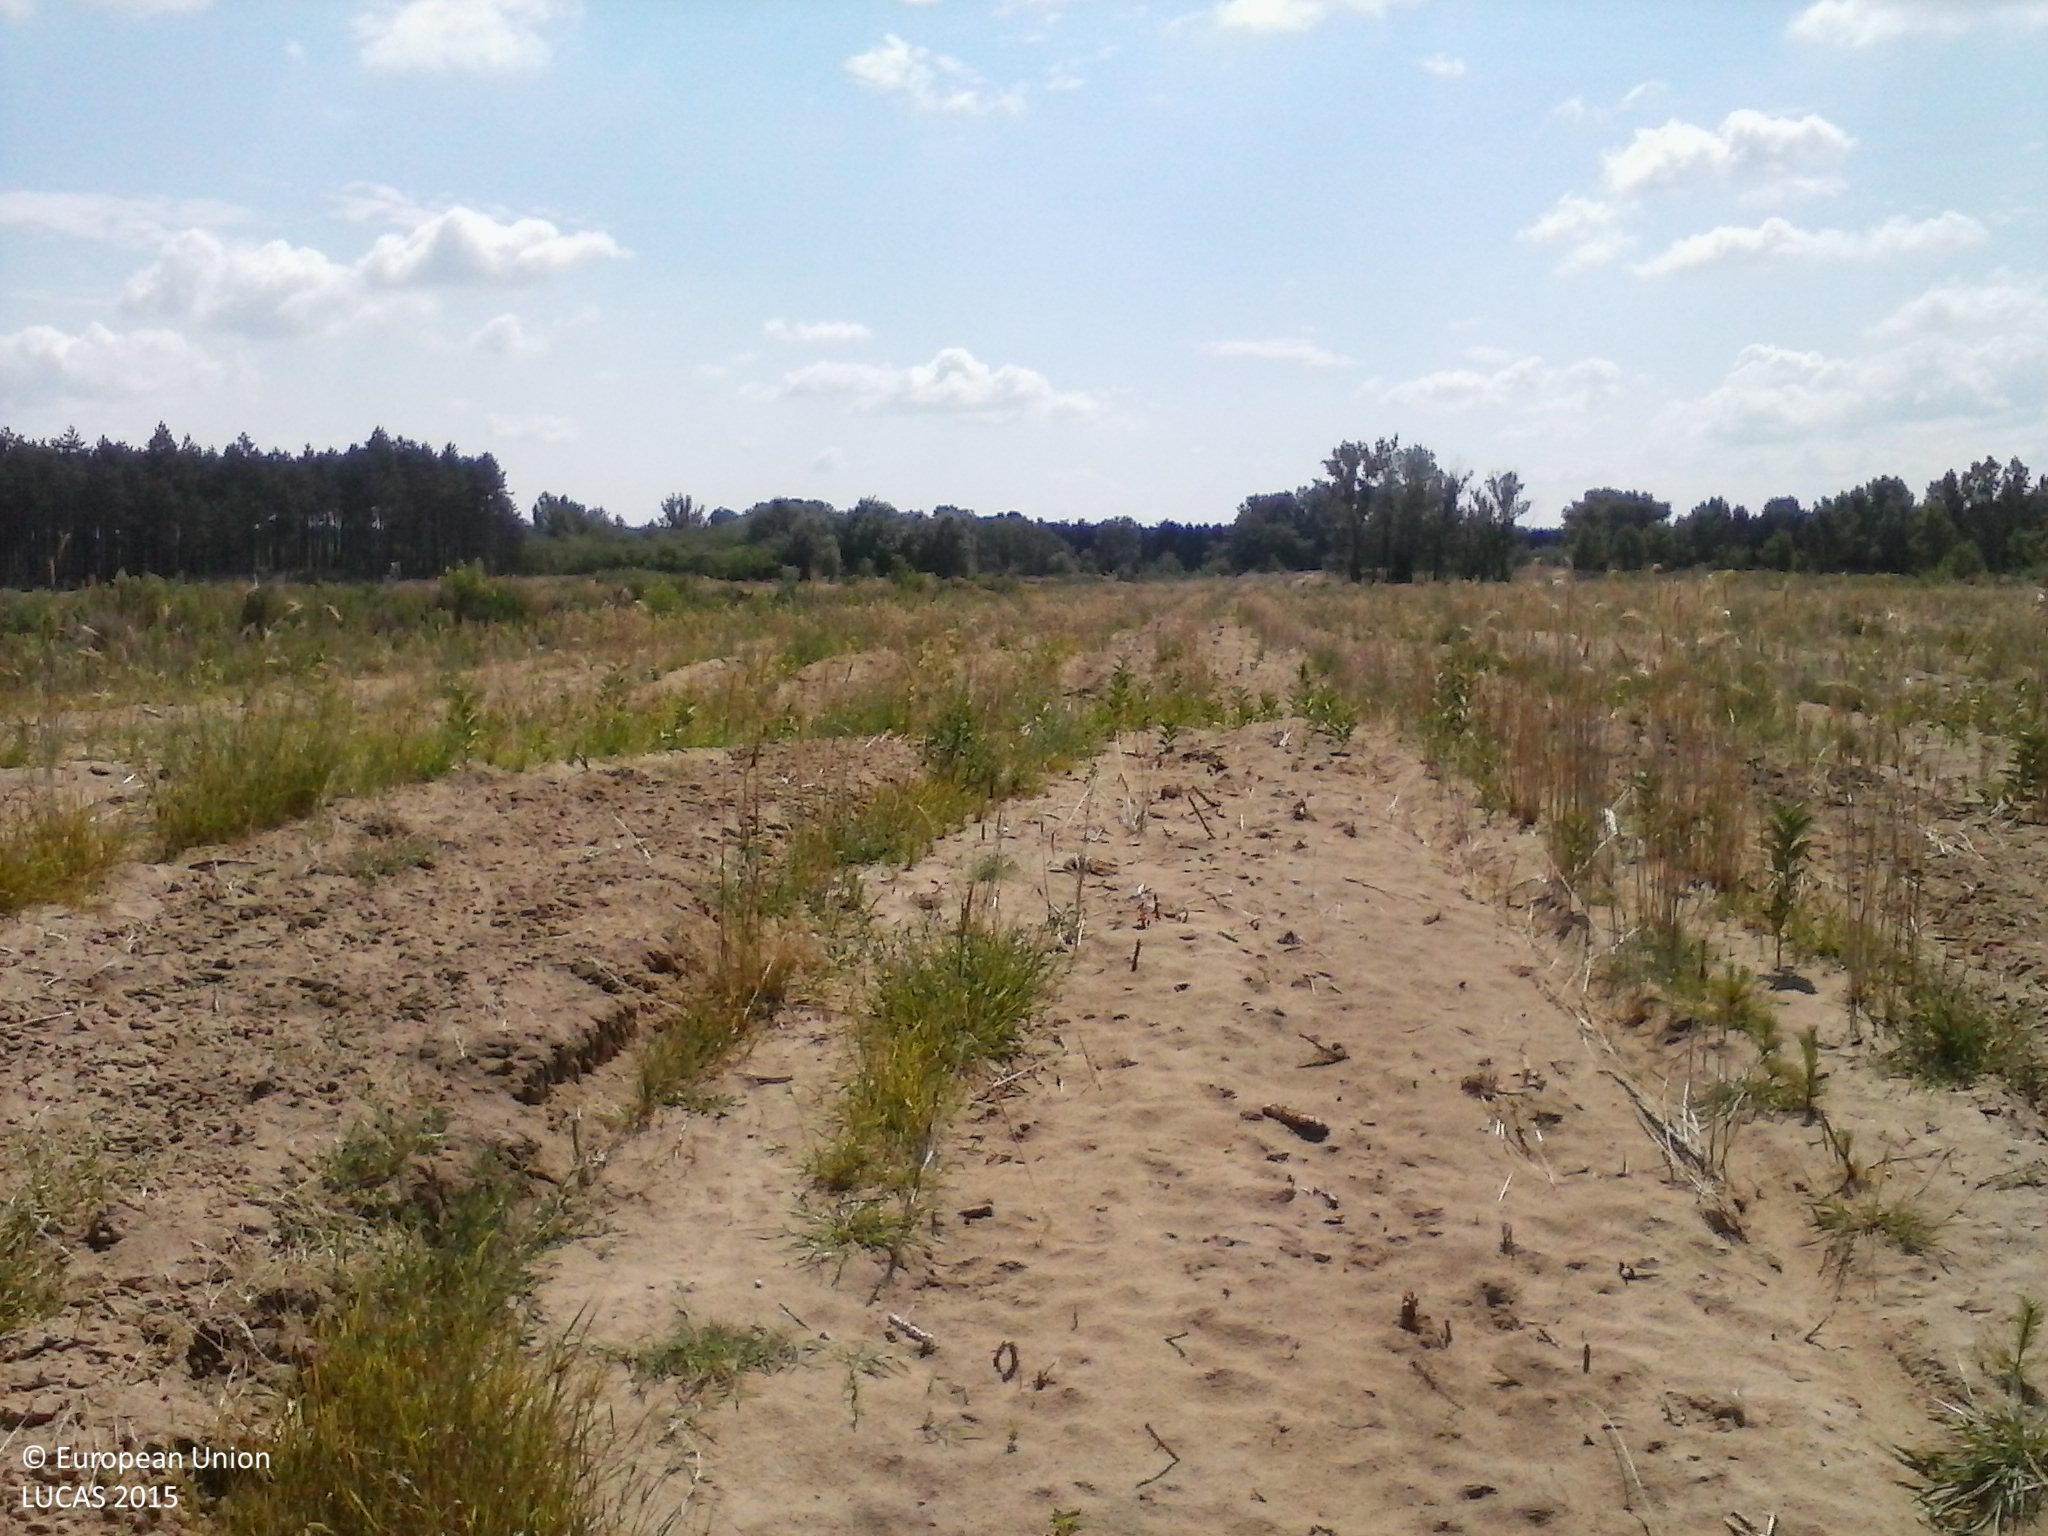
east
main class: Grassland
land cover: Spontaneously vegetated surfaces
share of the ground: 50 - 75 %
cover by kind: herbaceous plants 70 %, unconsolidated bare surface 25 %
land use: Forestry
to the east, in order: Spontaneously vegetated surfaces; Sand
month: July
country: HU
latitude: 46.5930
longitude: 19.5597
